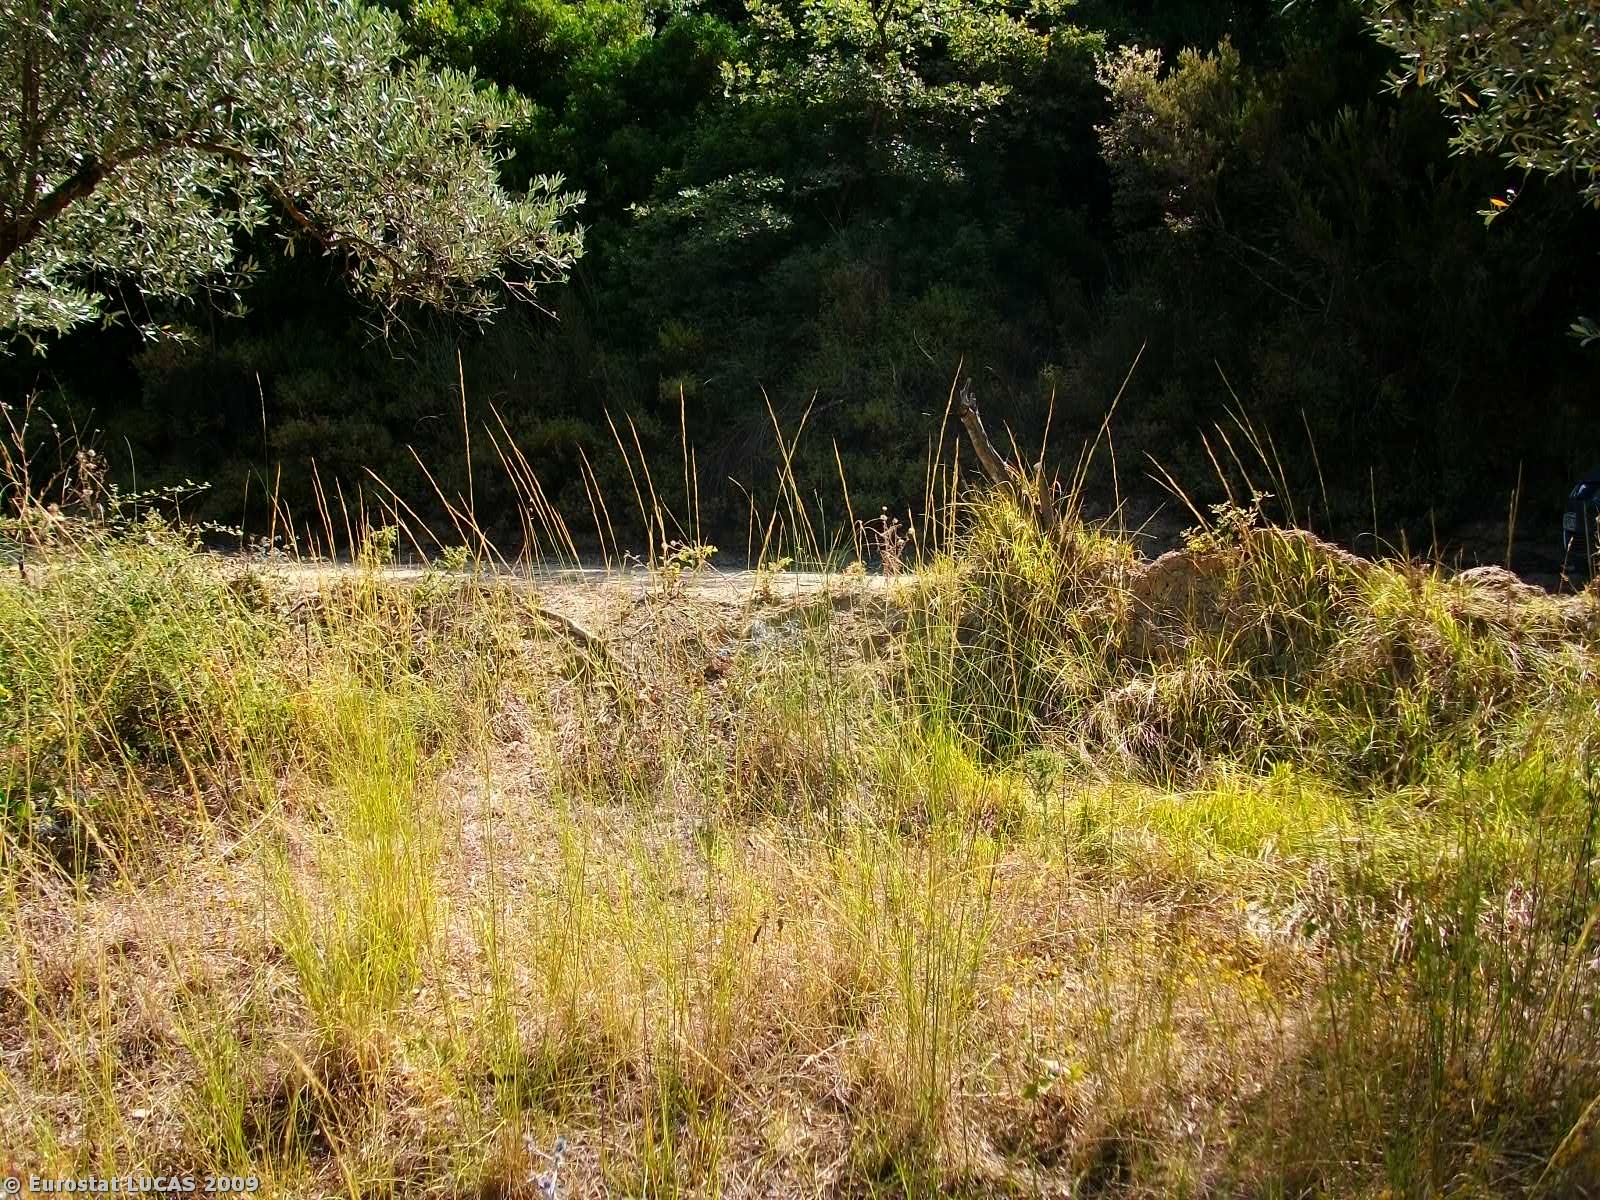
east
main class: Woodland
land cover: Broadleaved woodland
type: broadleaved evergreen forest
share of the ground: > 75 %
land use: Forestry
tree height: > 5 m
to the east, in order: Broadleaved woodland; Spontaneously vegetated surfaces; Tracks; Broadleaved woodland
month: July
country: GR
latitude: 38.6422
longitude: 21.4711
